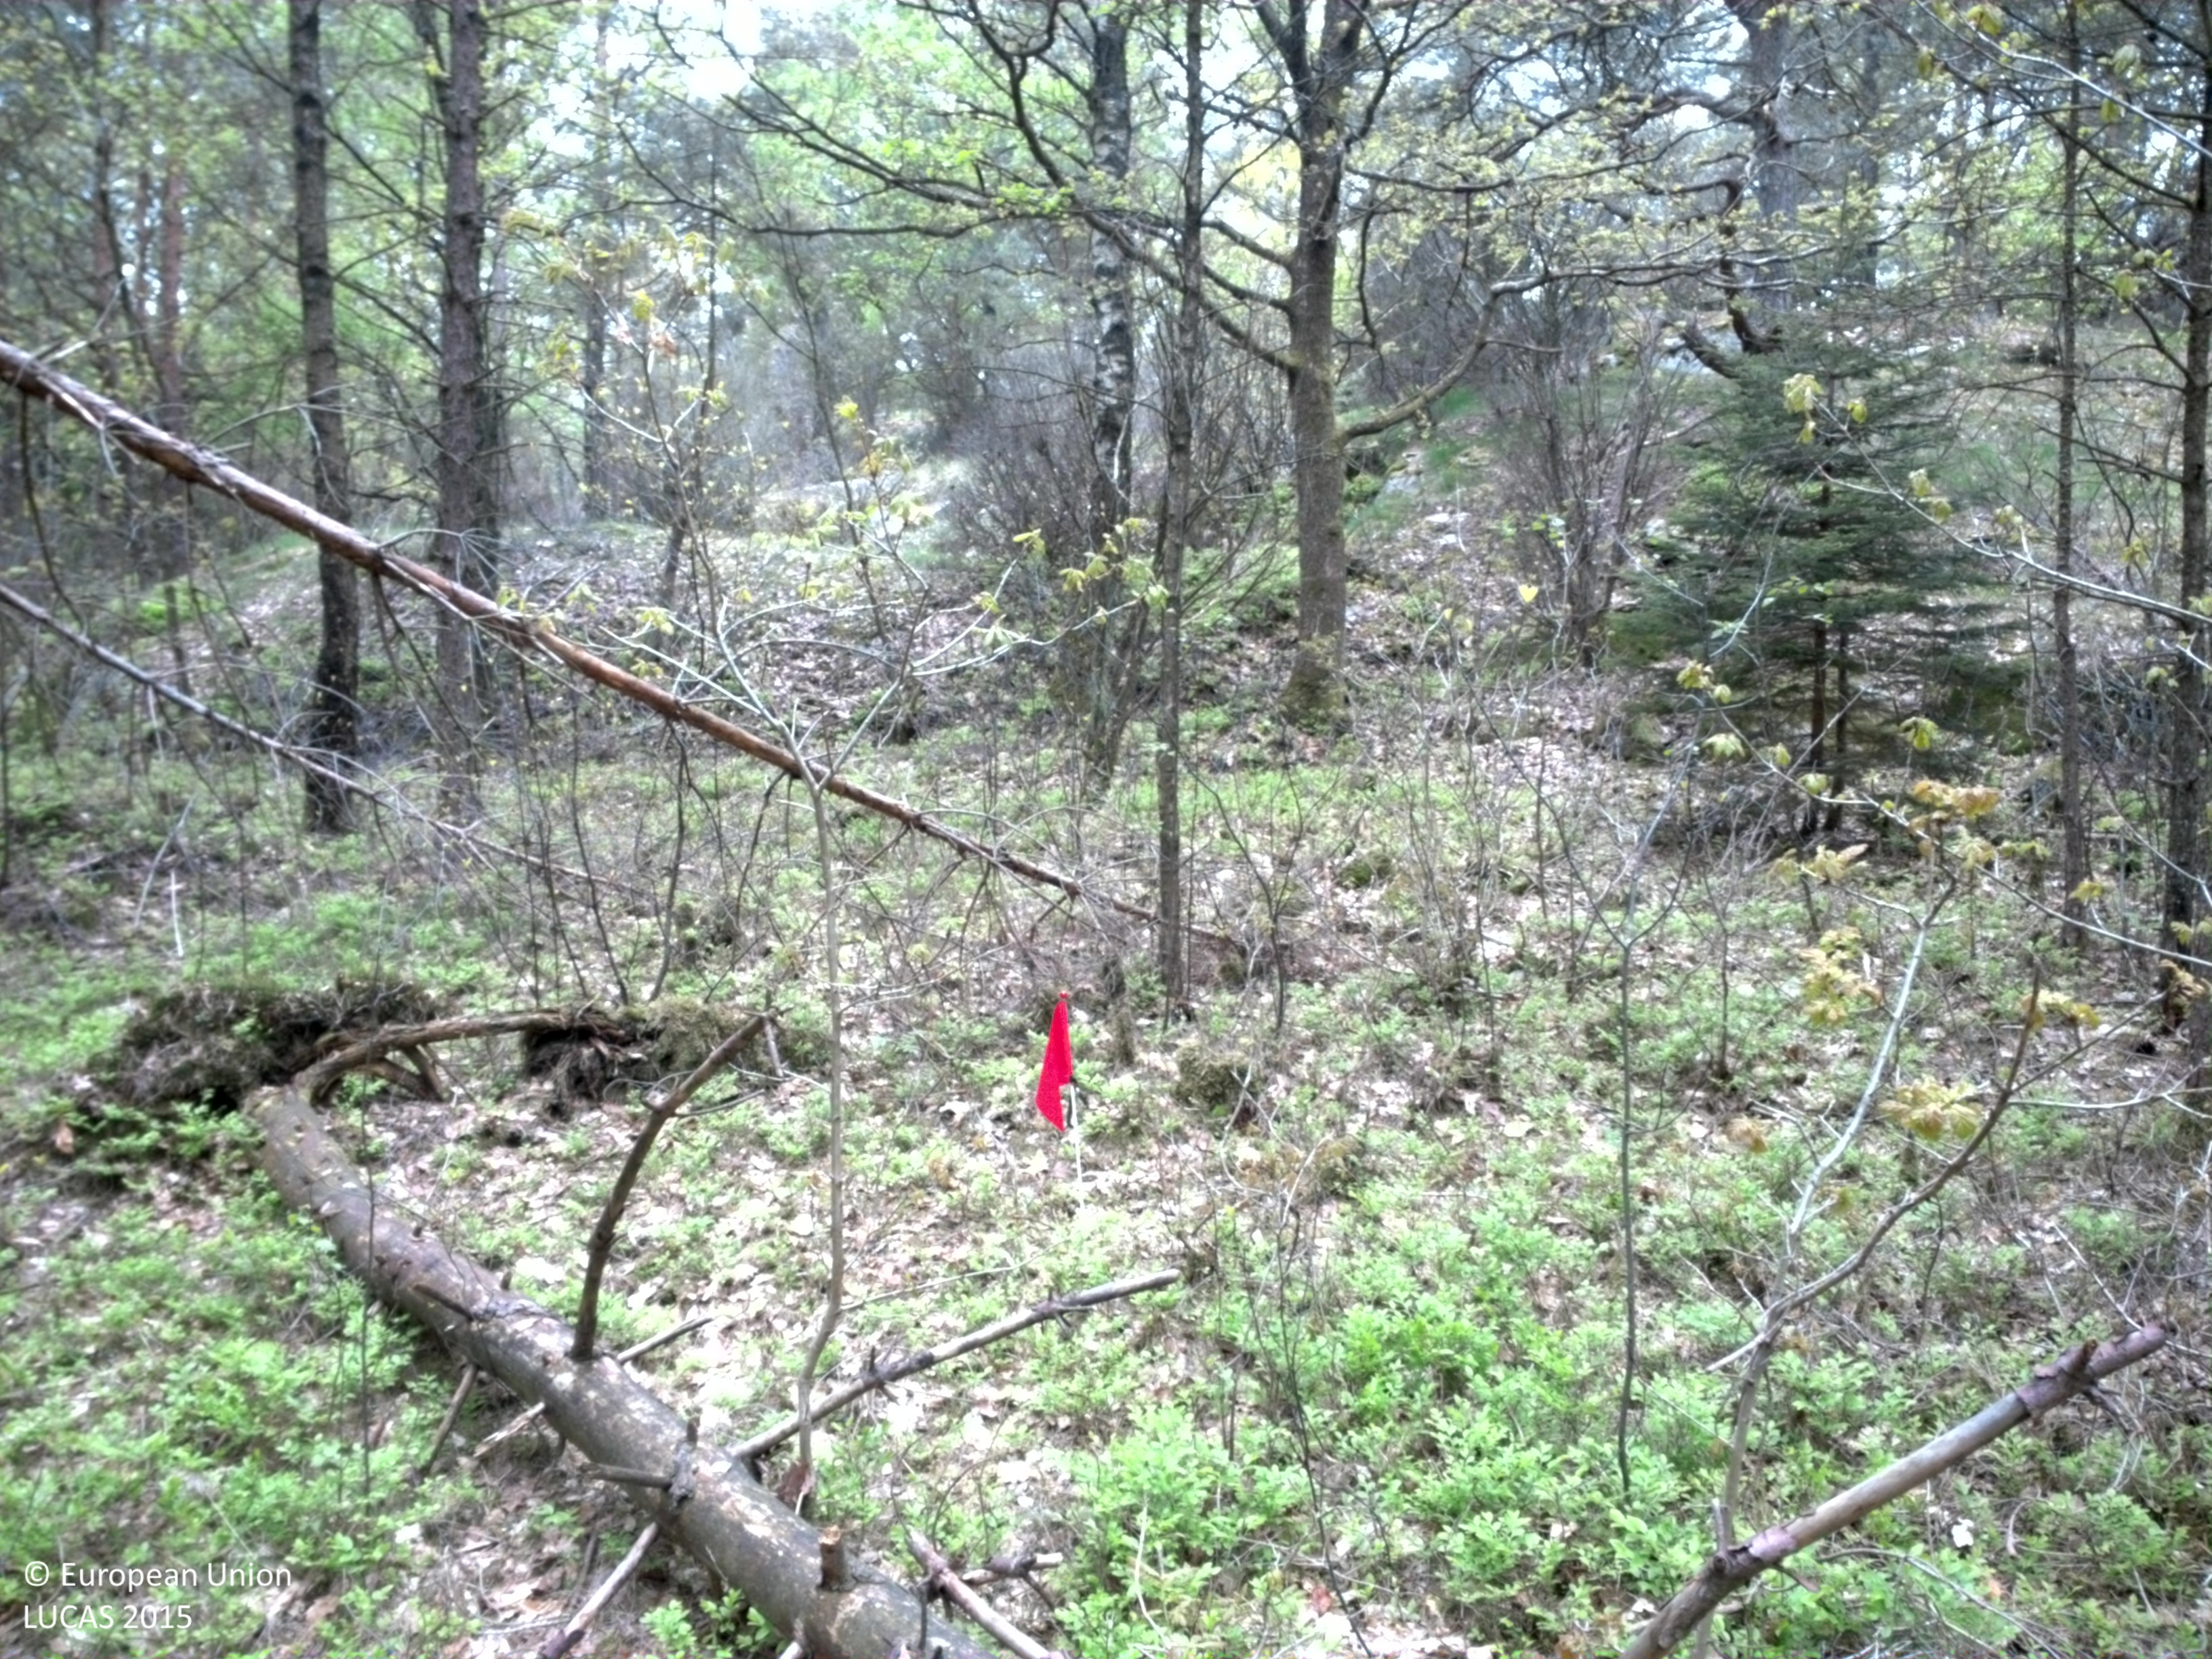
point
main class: Woodland
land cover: Pine dominated mixed woodland
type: boreal forest
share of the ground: > 75 %
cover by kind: coniferous forest trees 55 %, broadleaved forest trees 25 %, shrubs 15 %, herbaceous plants 5 %
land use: Forestry
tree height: > 5 m
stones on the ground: < 10 %
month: May
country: SE
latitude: 57.8093
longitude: 11.9657
